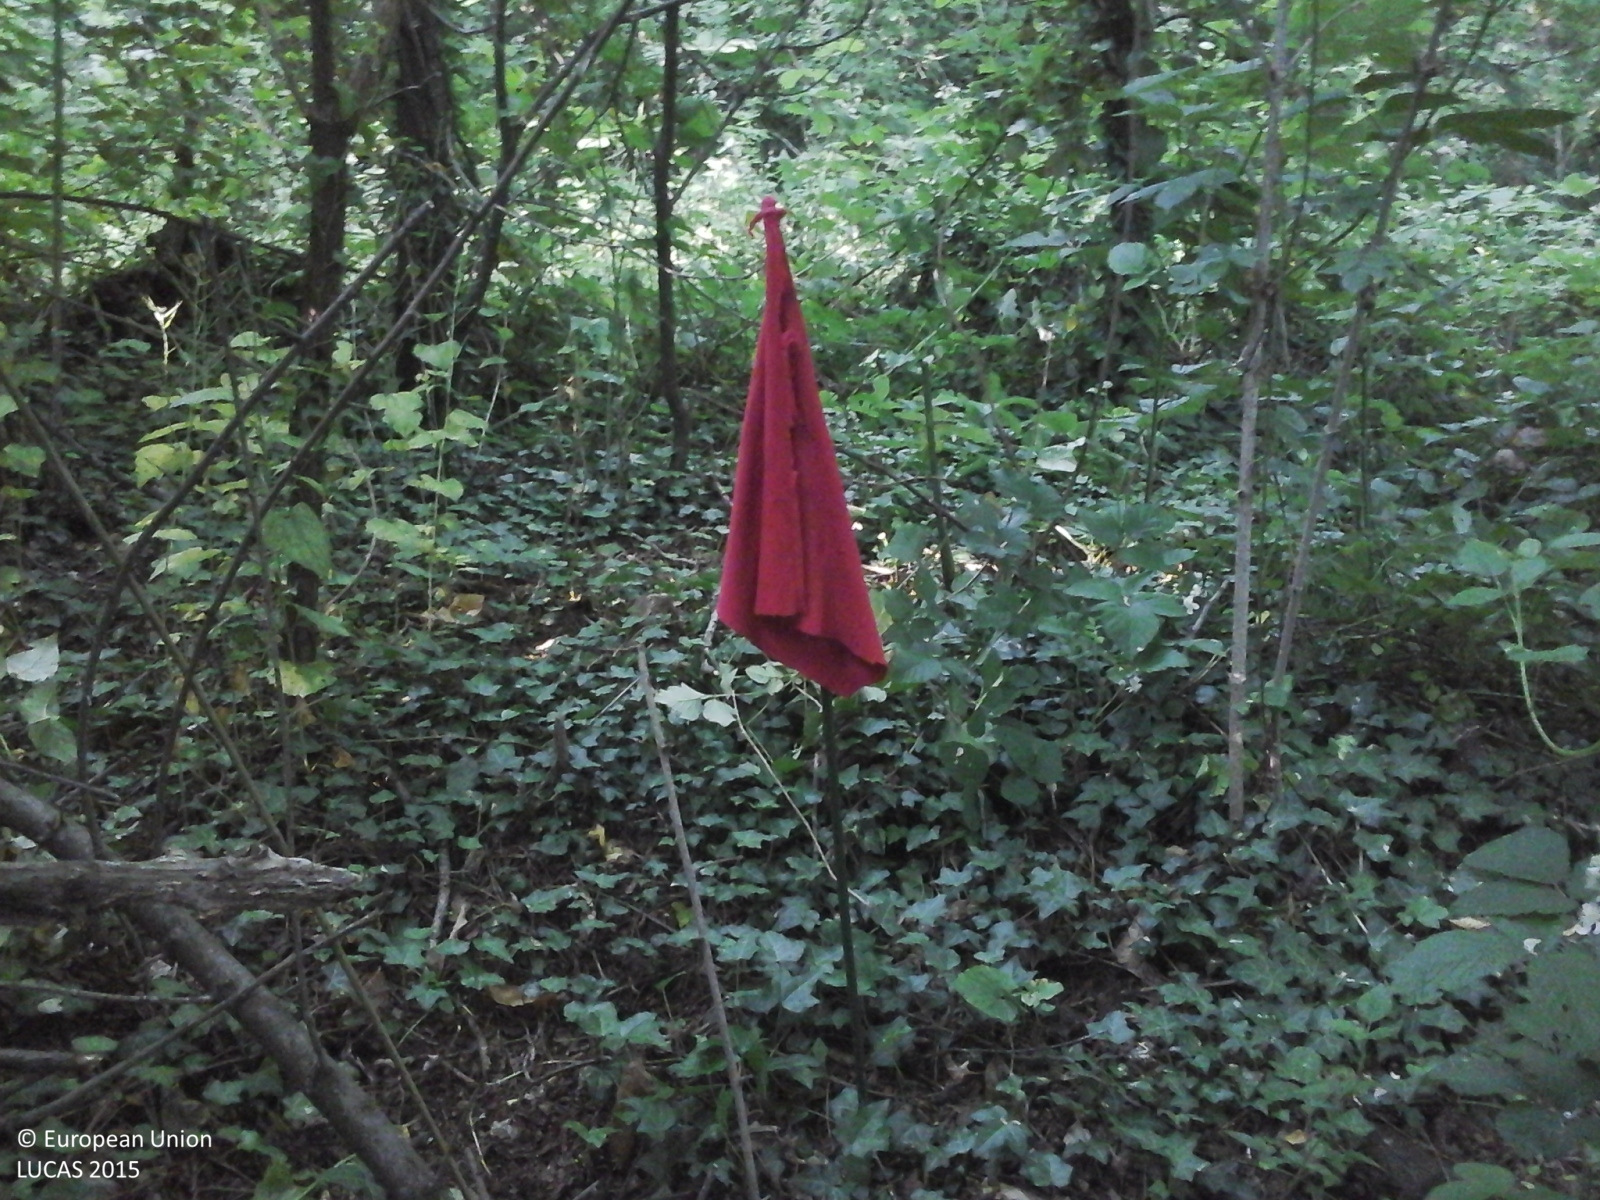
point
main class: Woodland
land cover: Broadleaved woodland
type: thermophilous deciduous forest
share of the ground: > 75 %
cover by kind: broadleaved forest trees 100 %
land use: Forestry
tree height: > 5 m
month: June
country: IT
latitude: 45.4498
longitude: 8.0213
